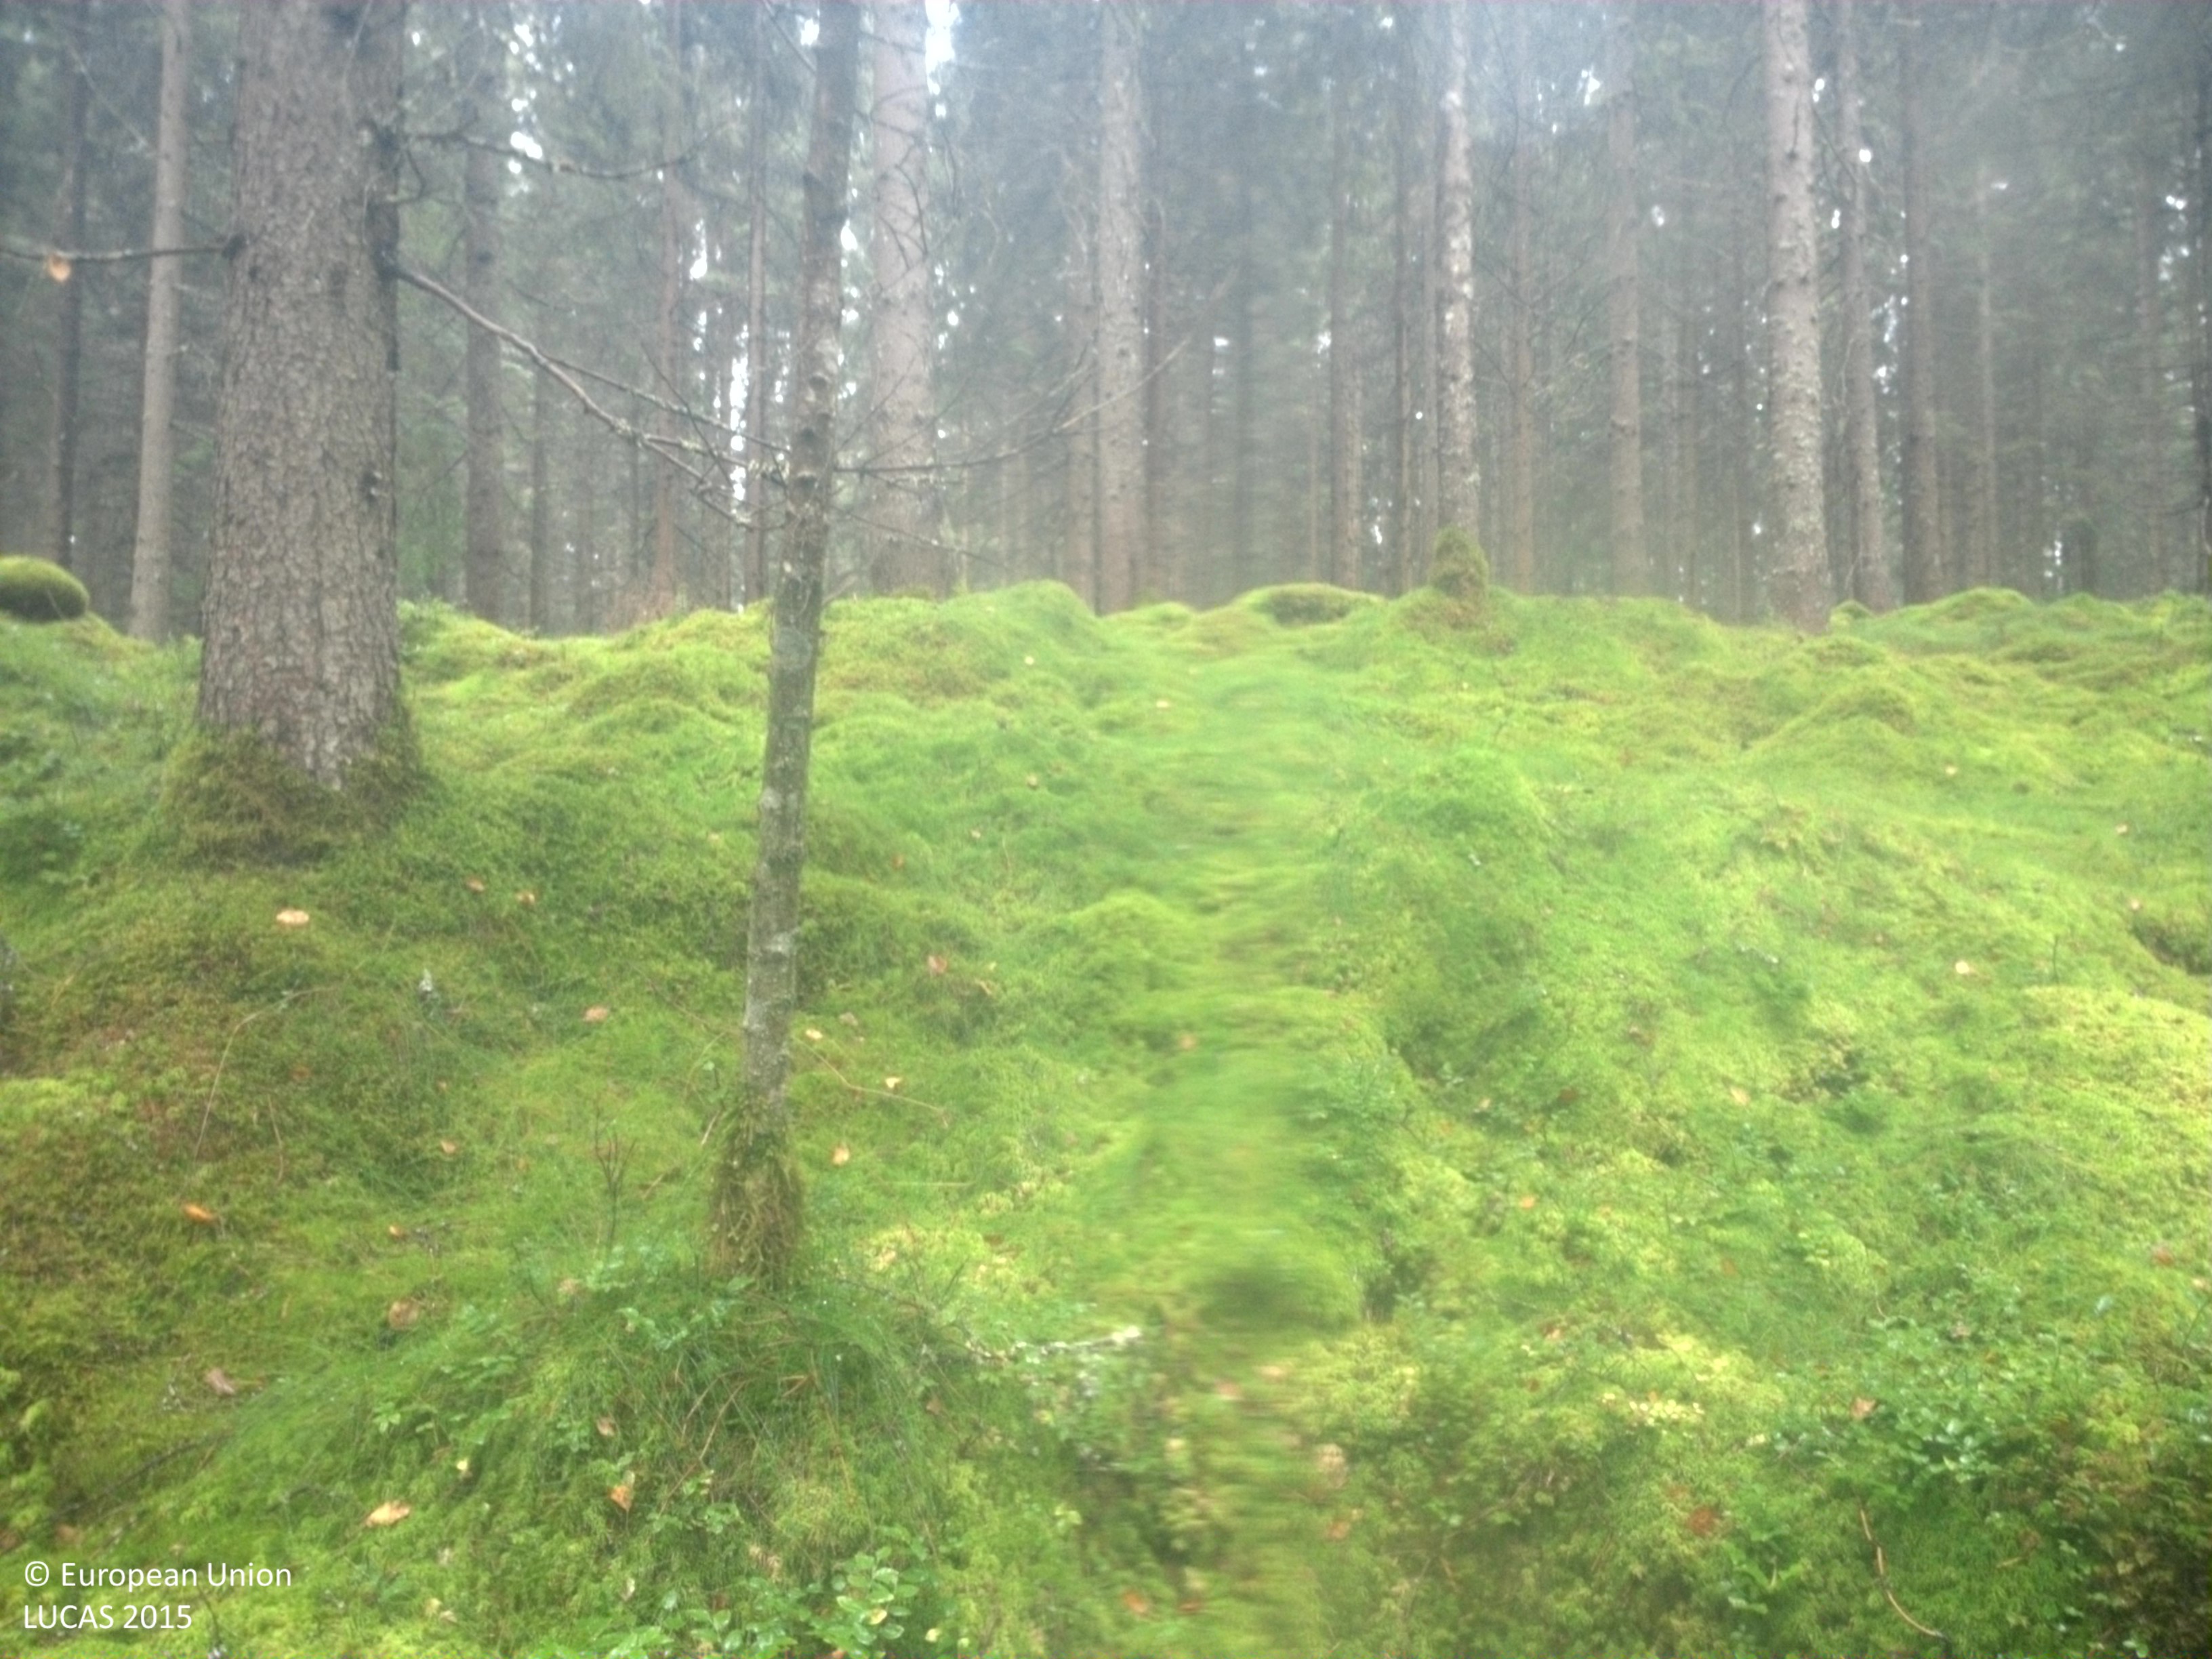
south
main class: Woodland
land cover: Spruce dominated coniferous woodland
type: boreal forest
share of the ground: 50 - 75 %
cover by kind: coniferous forest trees 50 %, lichens and mosses 50 %
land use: Forestry
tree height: > 5 m
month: August
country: SE
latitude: 57.7126
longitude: 13.2348
